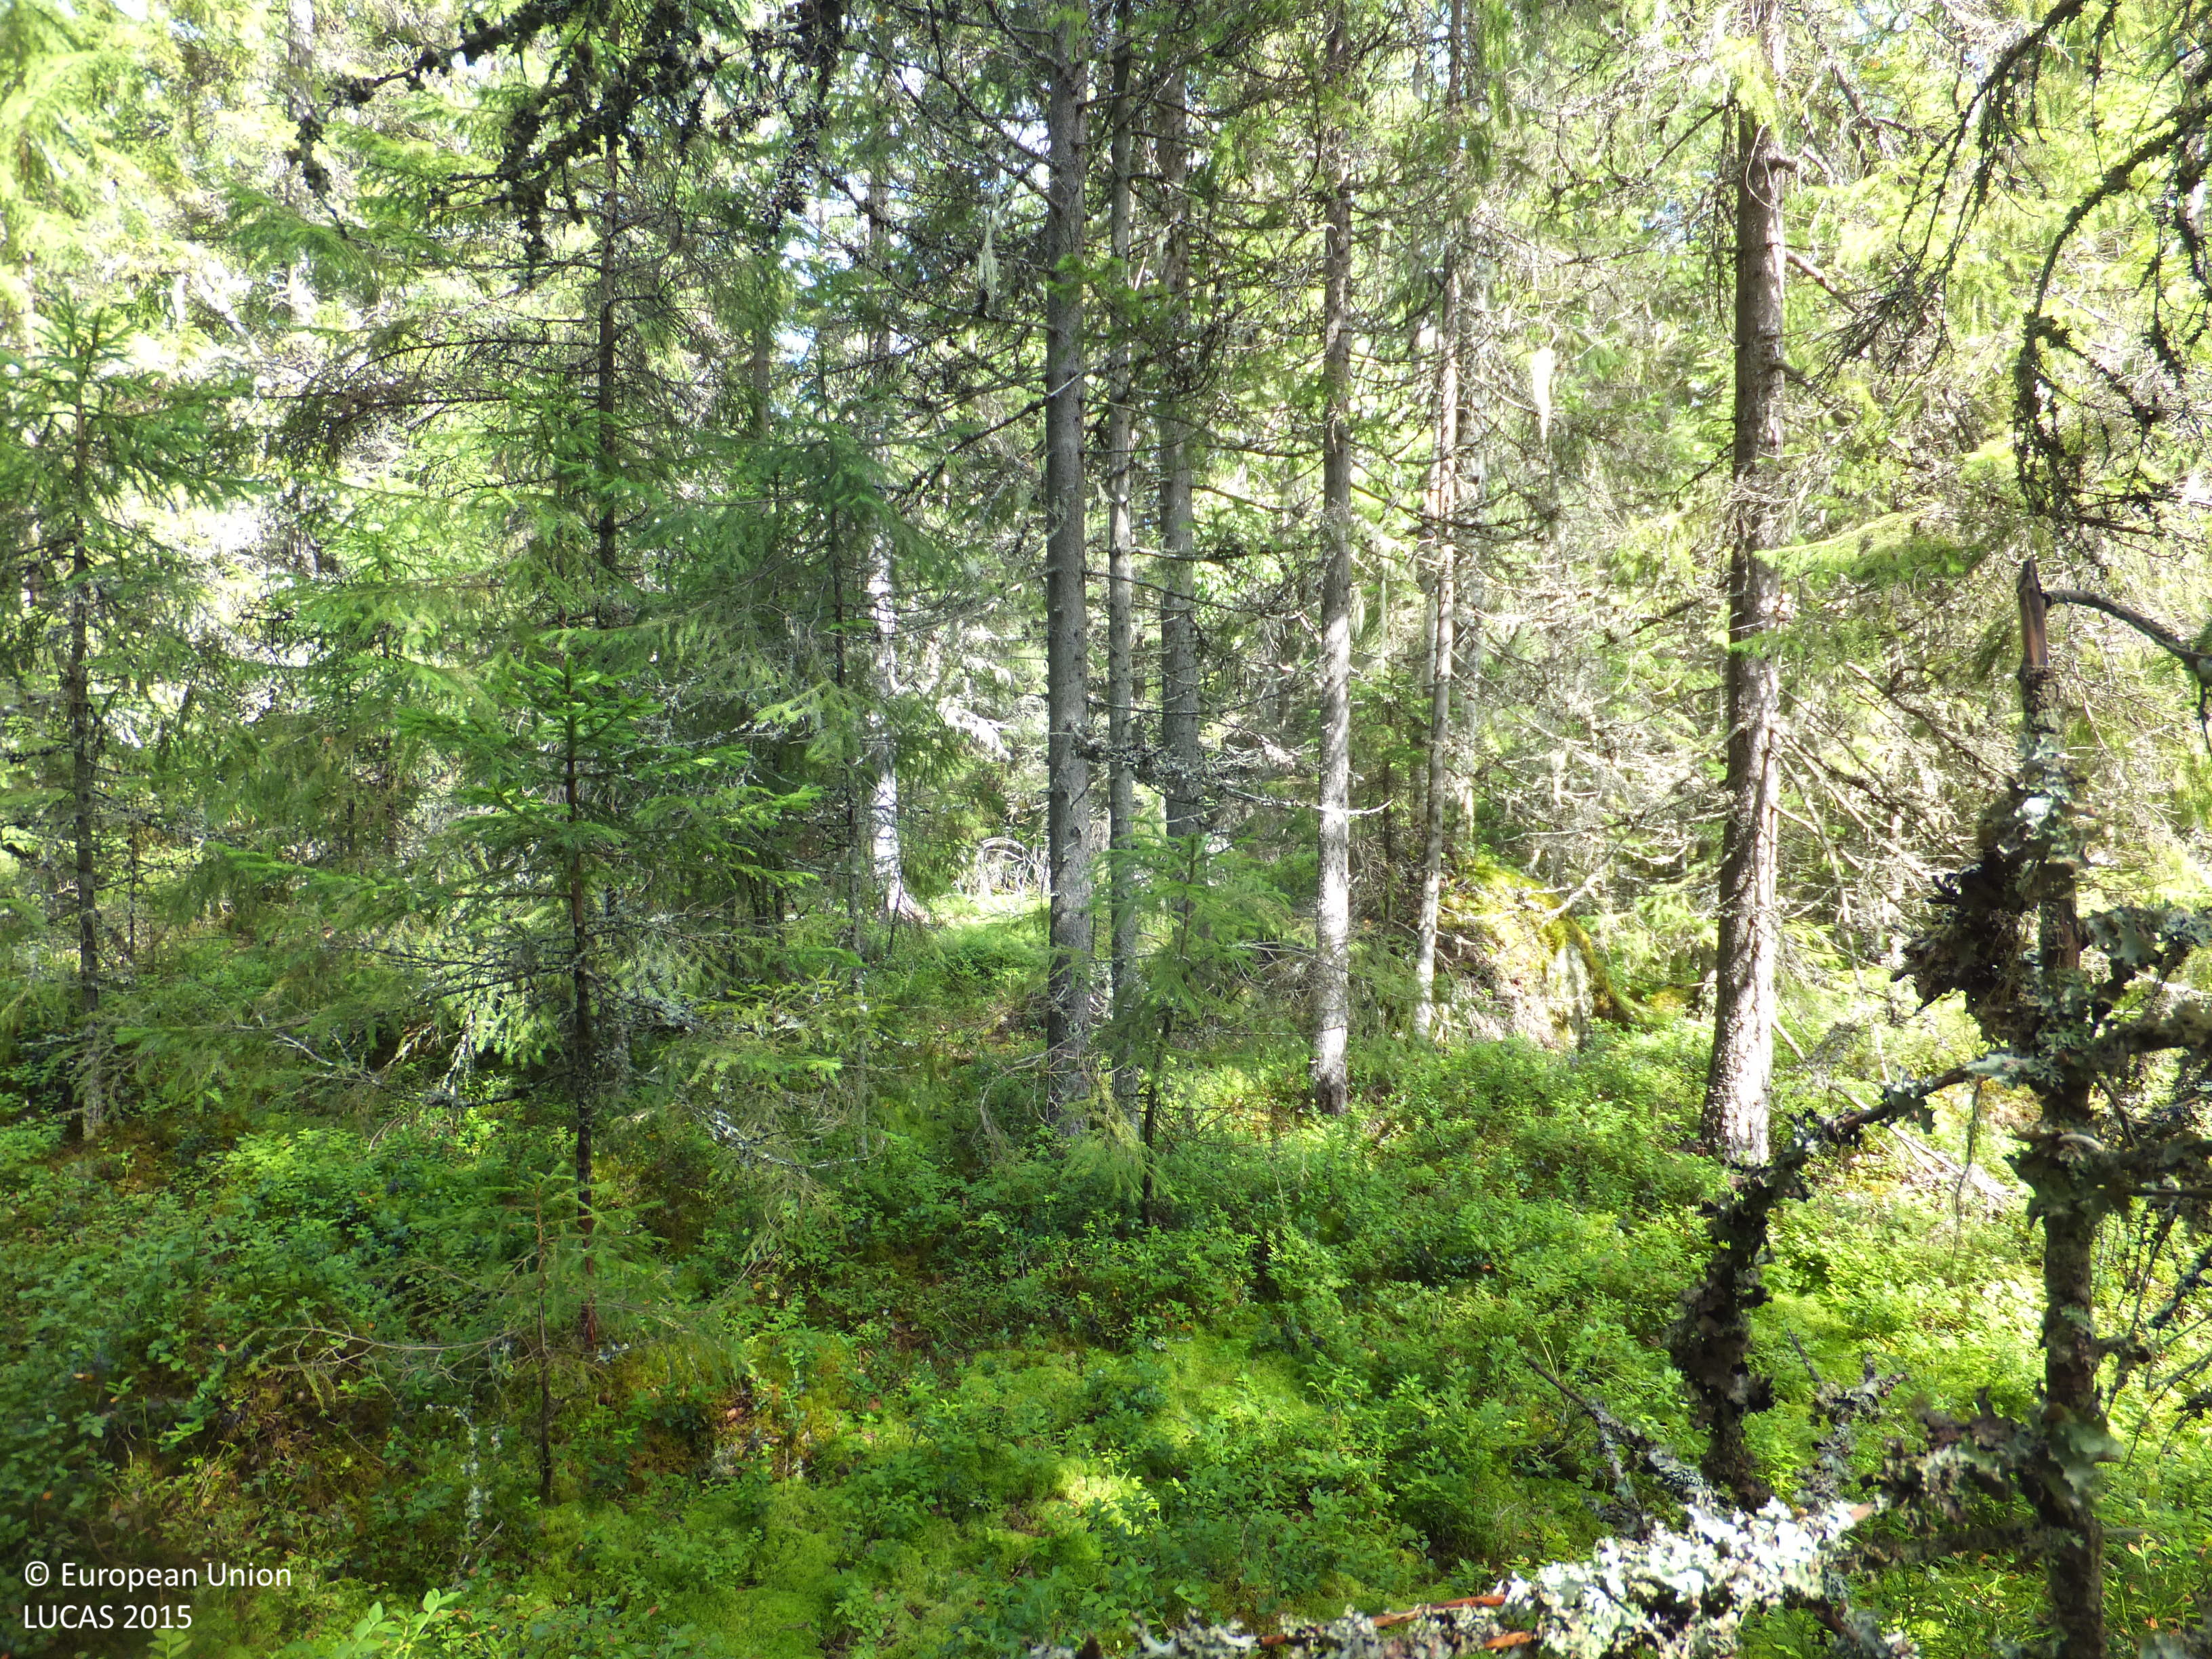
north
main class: Woodland
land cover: Spruce dominated coniferous woodland
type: boreal forest
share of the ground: 50 - 75 %
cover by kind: coniferous forest trees 65 %, shrubs 15 %, lichens and mosses 10 %, broadleaved forest trees 5 %, herbaceous plants 5 %
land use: Forestry
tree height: > 5 m
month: July
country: FI
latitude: 63.2743
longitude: 22.1023
